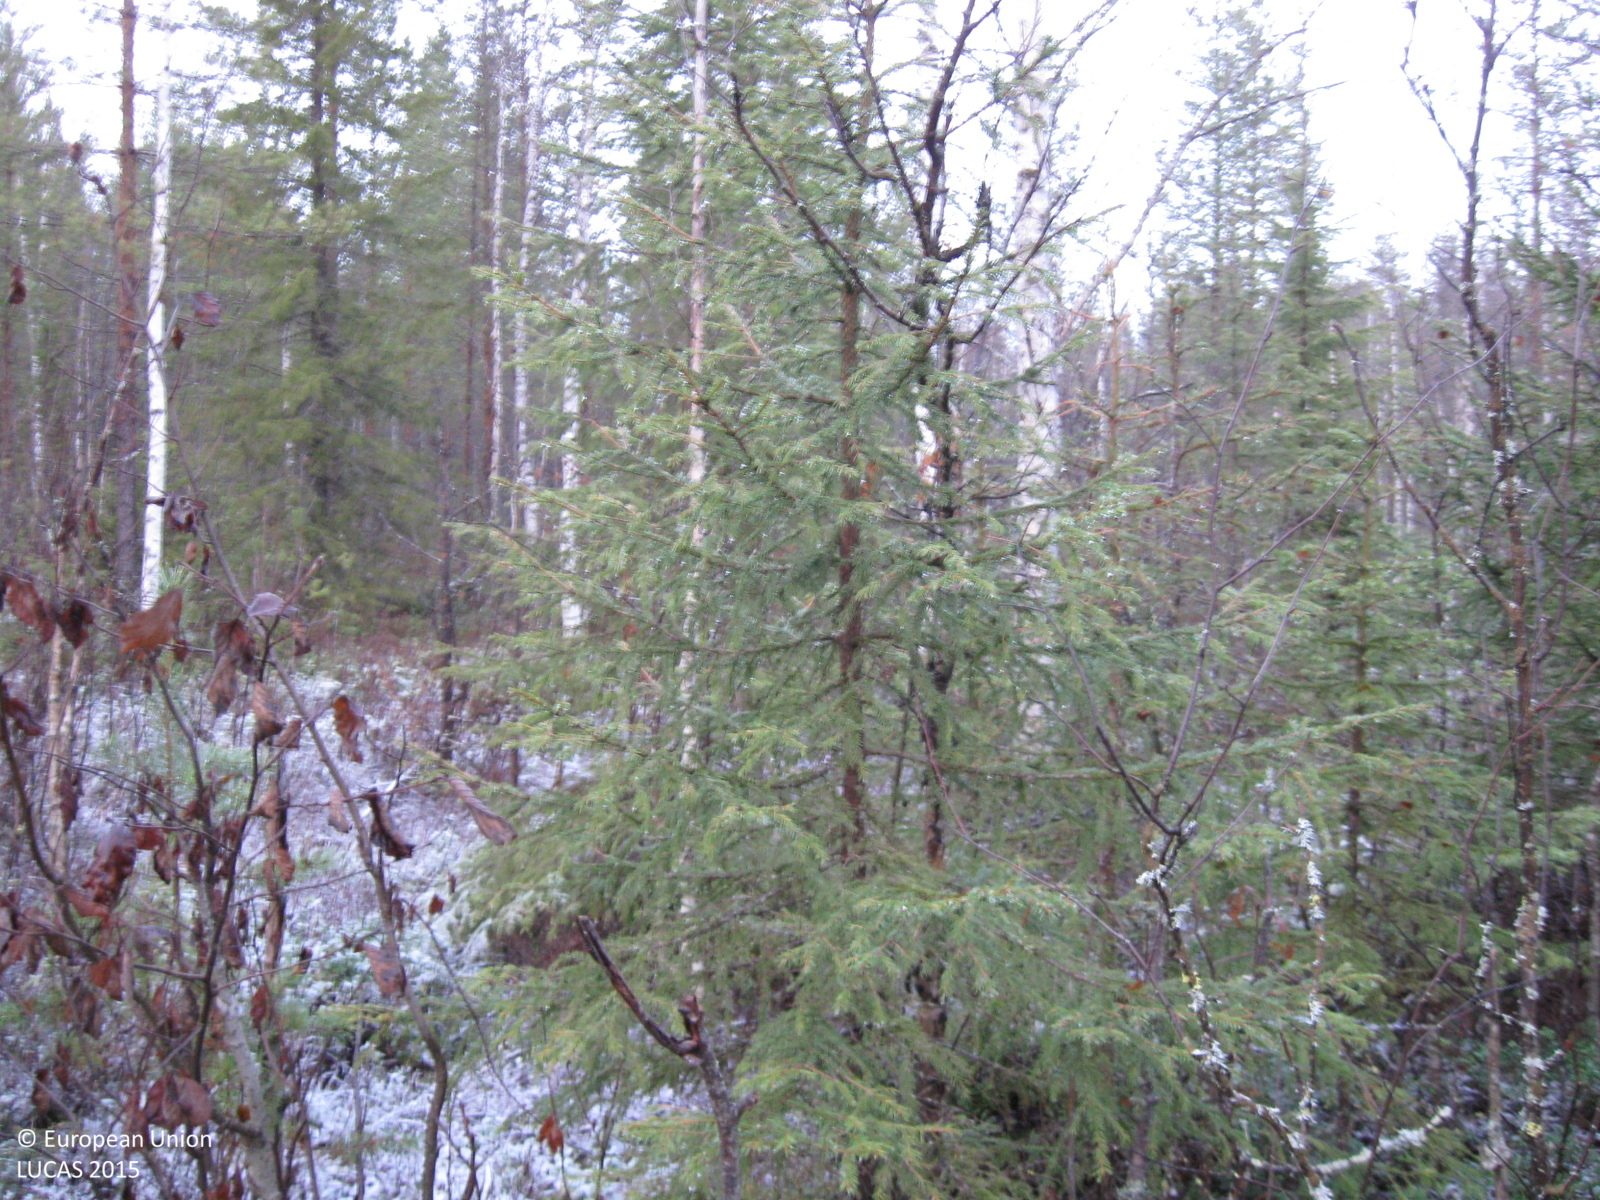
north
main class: Woodland
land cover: Spruce dominated mixed woodland
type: boreal forest
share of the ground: > 75 %
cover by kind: broadleaved forest trees 55 %, coniferous forest trees 20 %, shrubs 10 %, herbaceous plants 10 %, lichens and mosses 5 %
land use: Forestry
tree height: > 5 m
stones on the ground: < 10 %
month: October
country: SE
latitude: 66.2203
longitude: 20.8293
